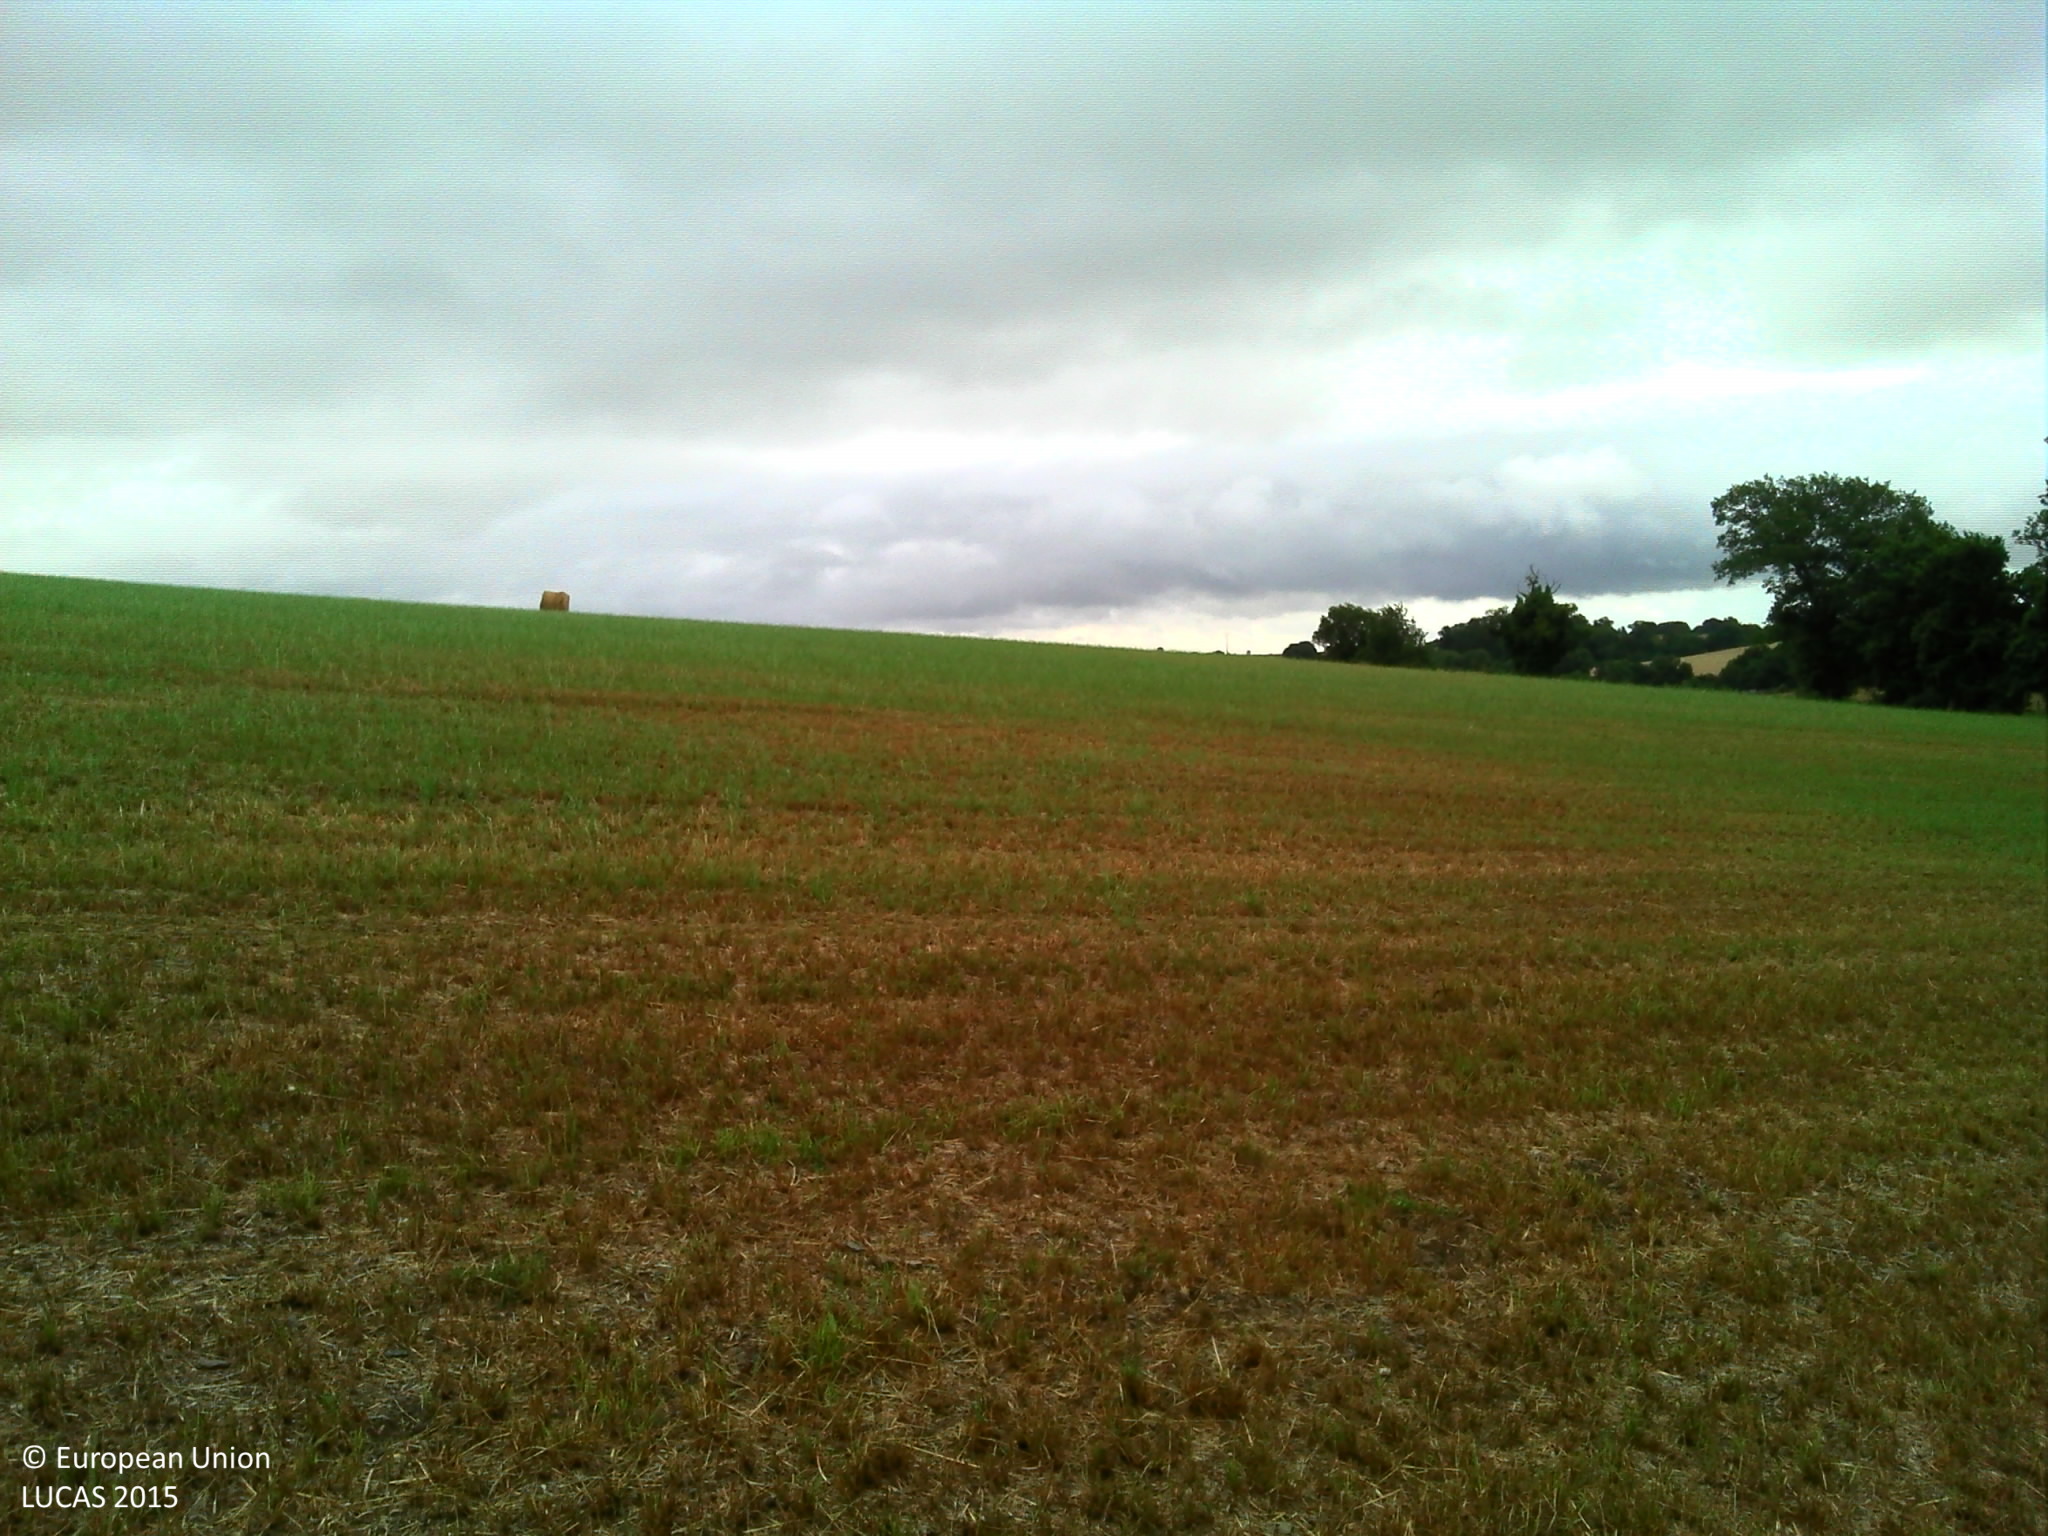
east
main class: Cropland
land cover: Temporary grasslands
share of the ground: > 75 %
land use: Agriculture (excluding fallow land and kitchen gardens)
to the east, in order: Temporary grasslands
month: July
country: FR
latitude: 48.3153
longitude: -0.1577
